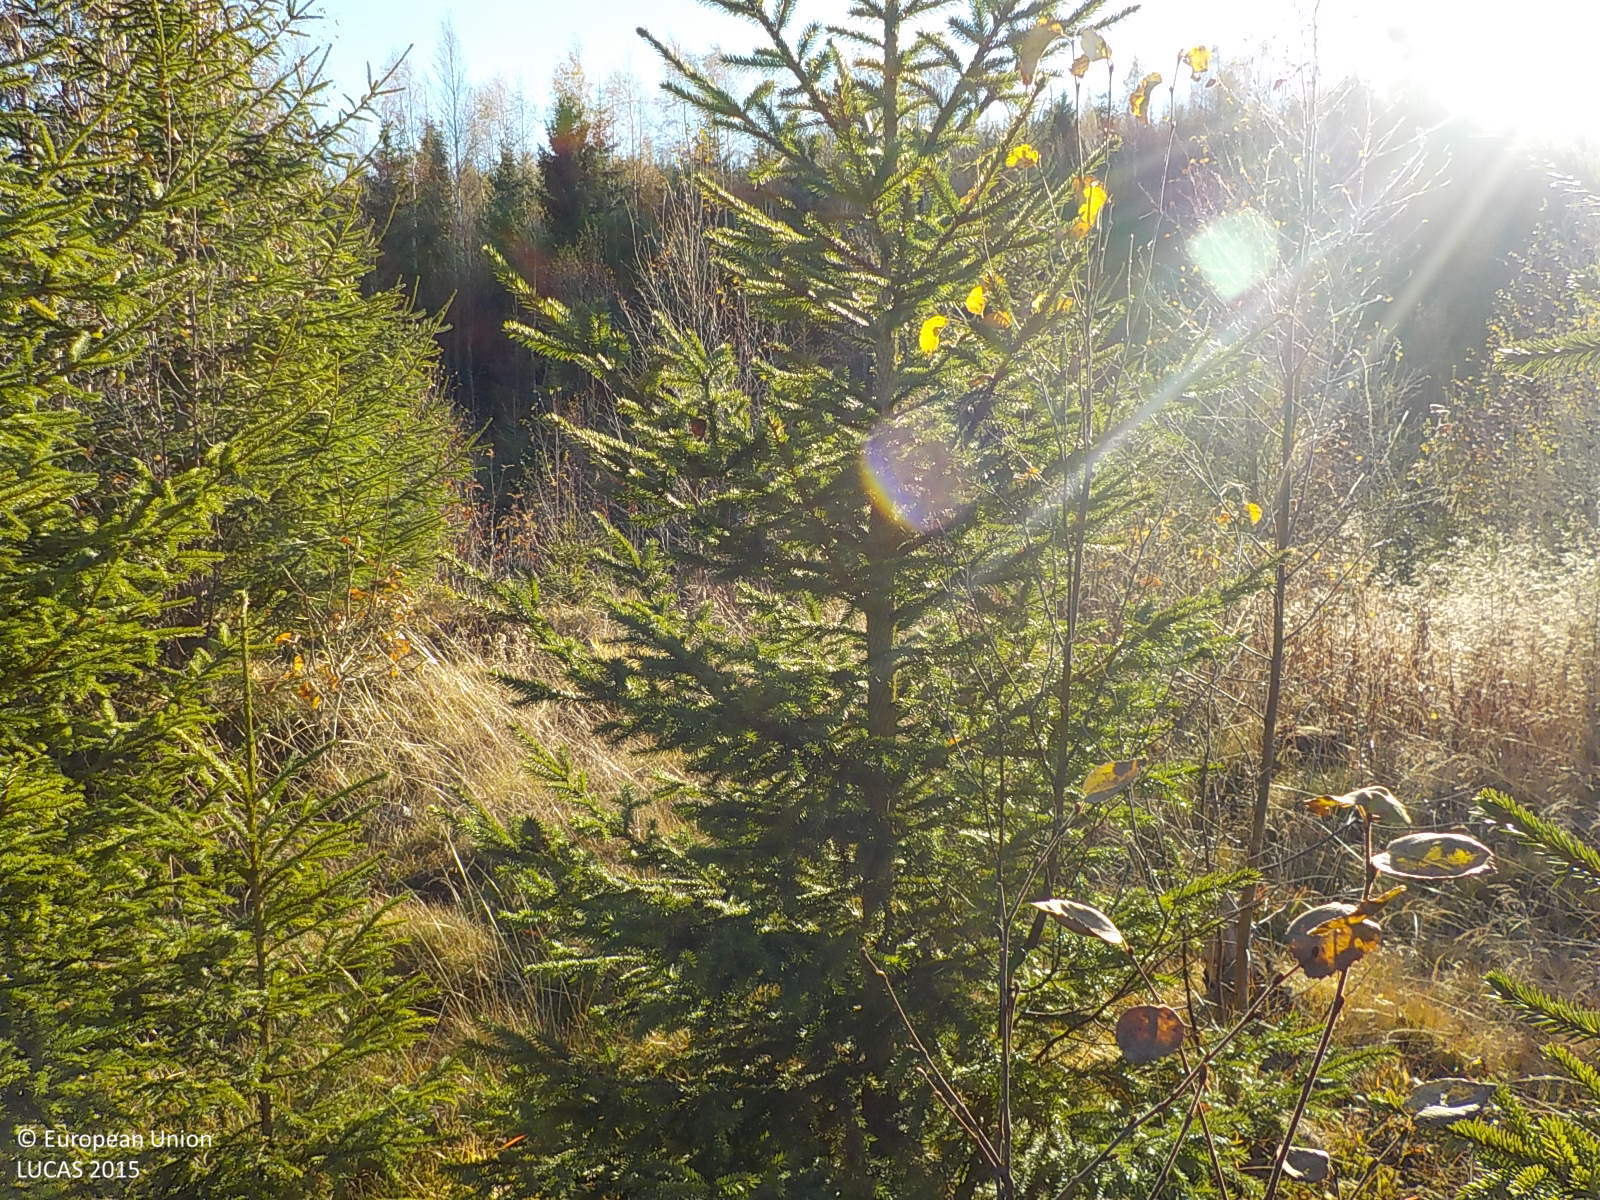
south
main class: Woodland
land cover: Spruce dominated mixed woodland
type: boreal forest
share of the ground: 50 - 75 %
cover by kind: coniferous forest trees 35 %, broadleaved forest trees 35 %, shrubs 30 %
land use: Forestry
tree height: < 5 m
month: October
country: SE
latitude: 63.0386
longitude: 18.2621
